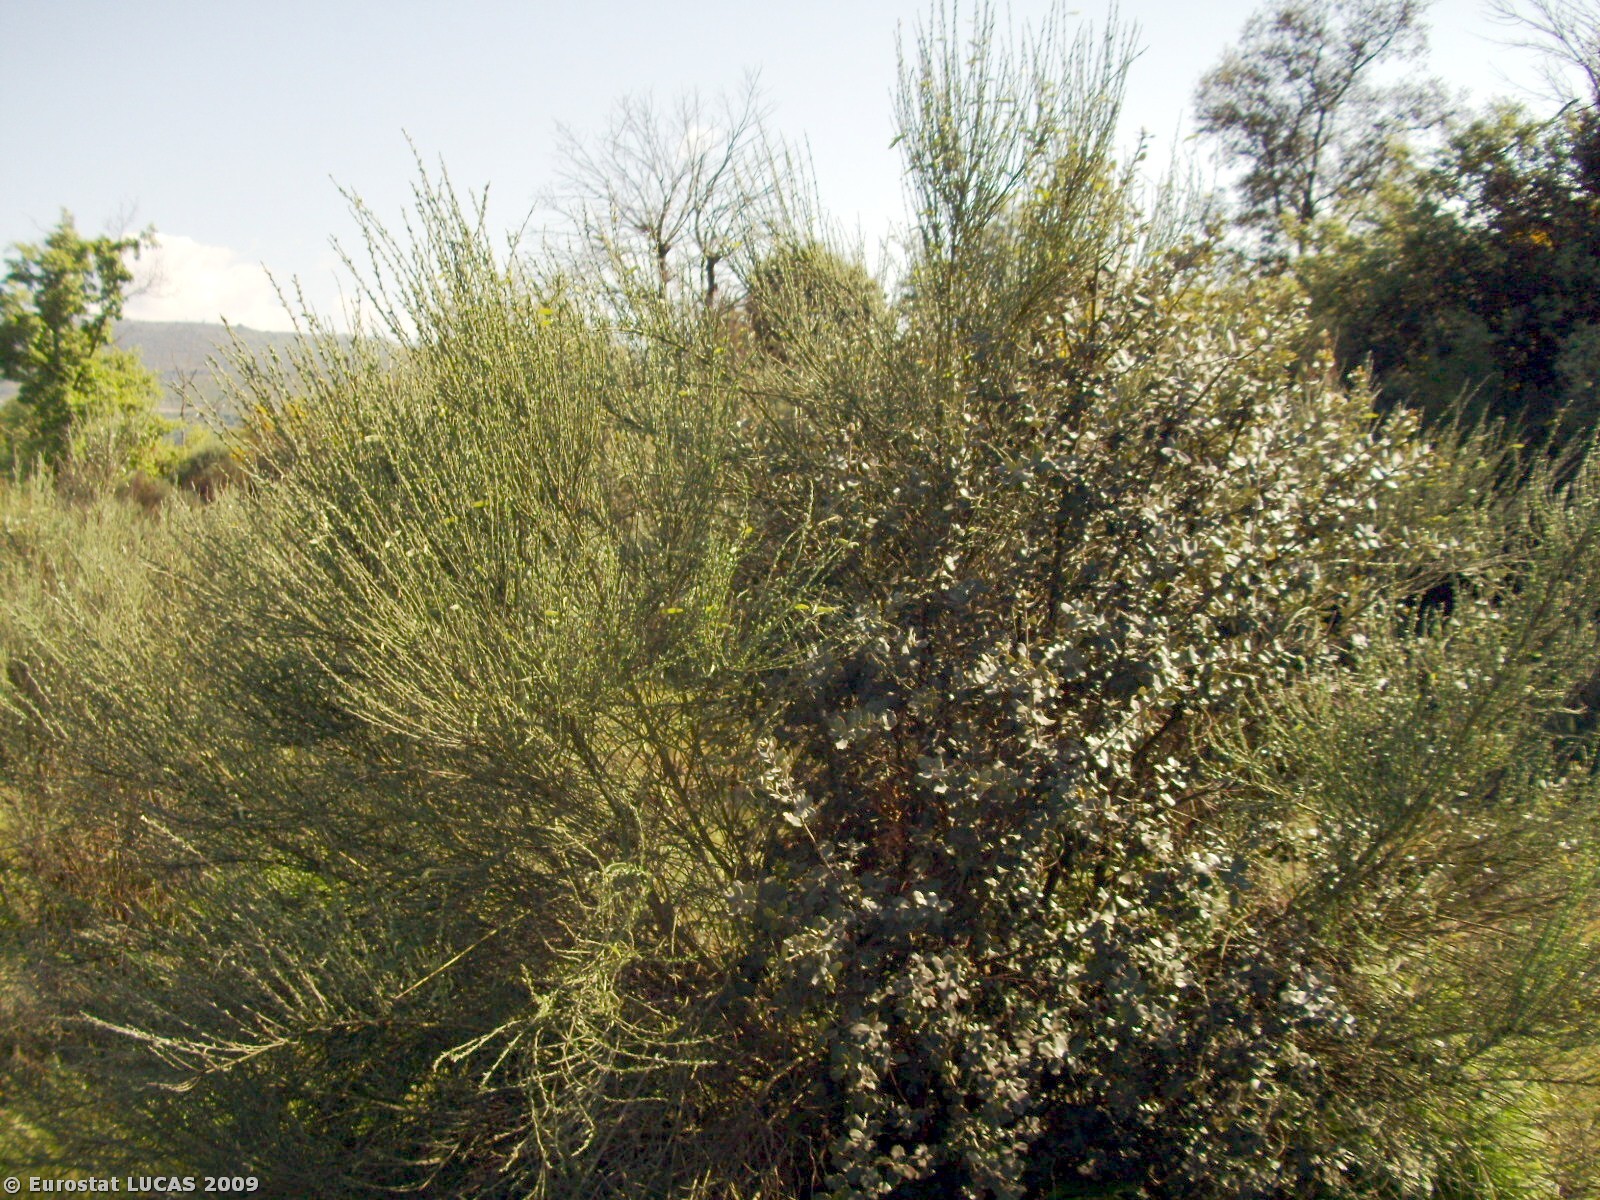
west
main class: Shrubland
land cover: Shrubland with sparse tree cover
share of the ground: > 75 %
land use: Nature reserves
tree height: > 5 m
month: May
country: PT
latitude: 40.6080
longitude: -7.3527
